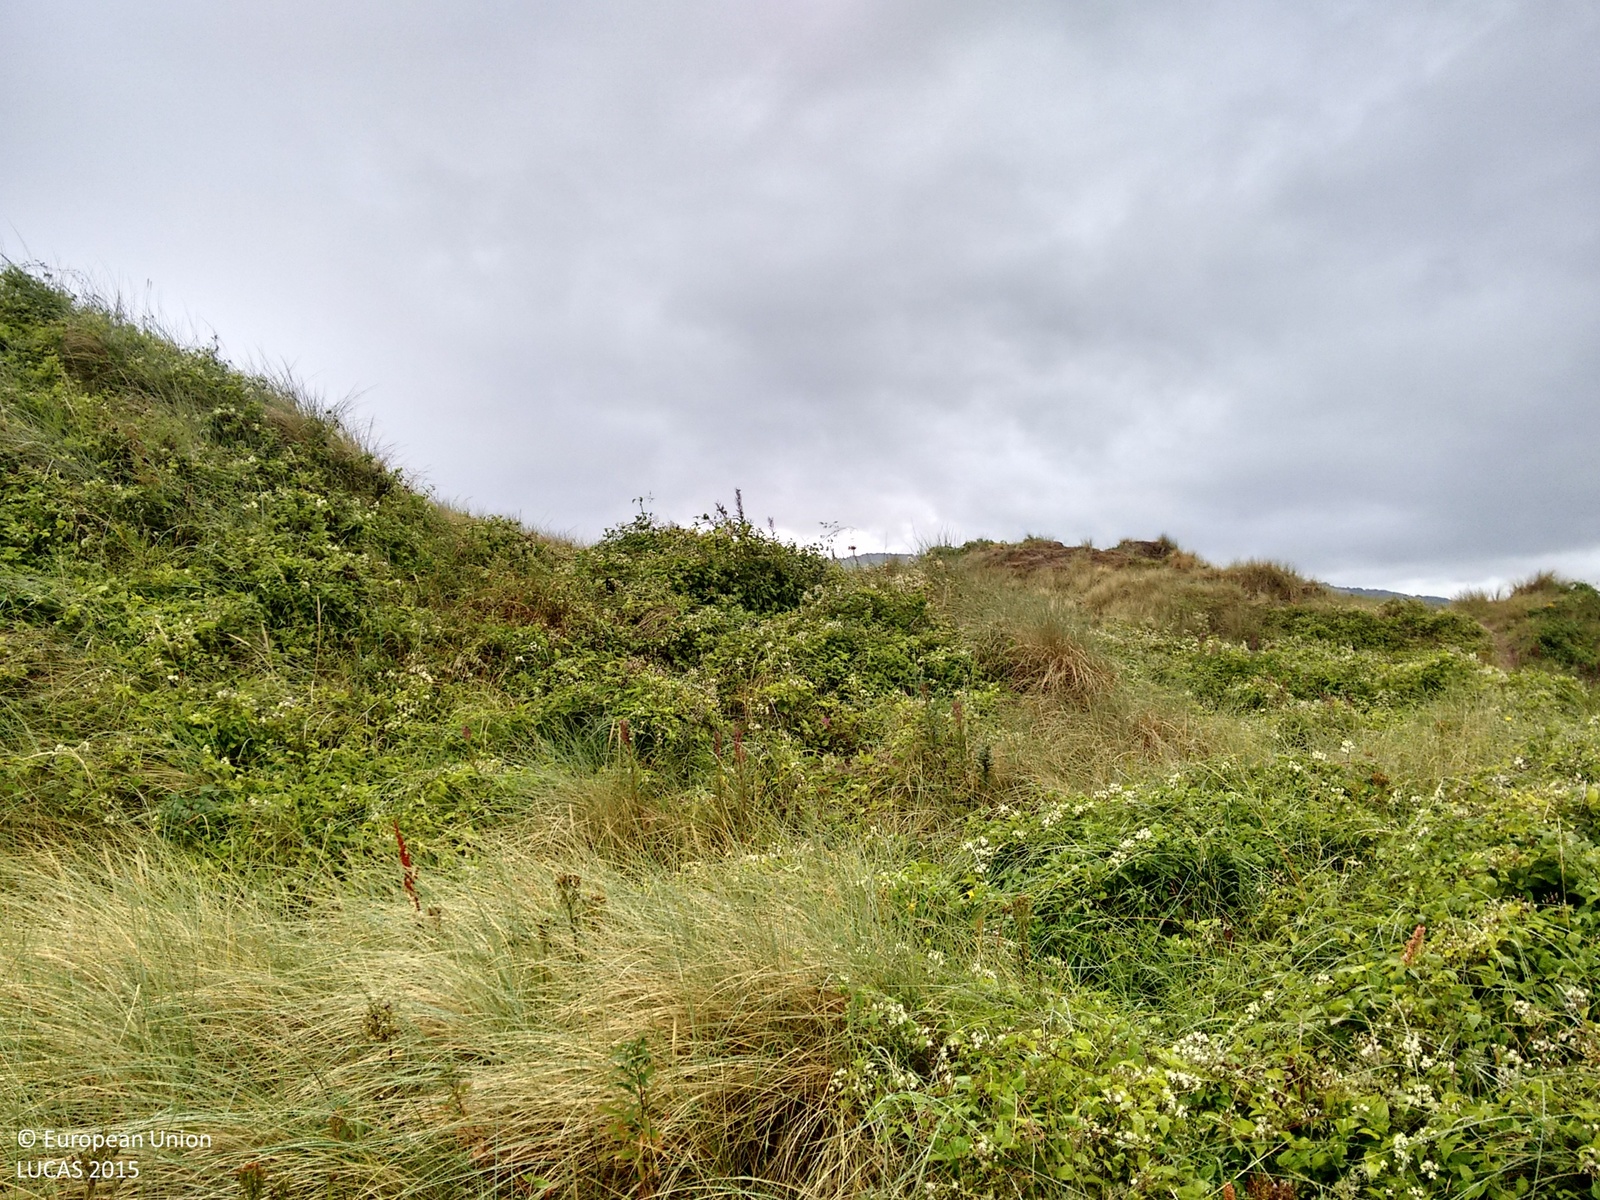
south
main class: Grassland
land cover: Grassland without tree/shrub cover
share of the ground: > 75 %
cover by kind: herbaceous plants 100 %
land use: Amenities, museums, leisure
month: August
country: GB
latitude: 53.3518
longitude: -3.3462
